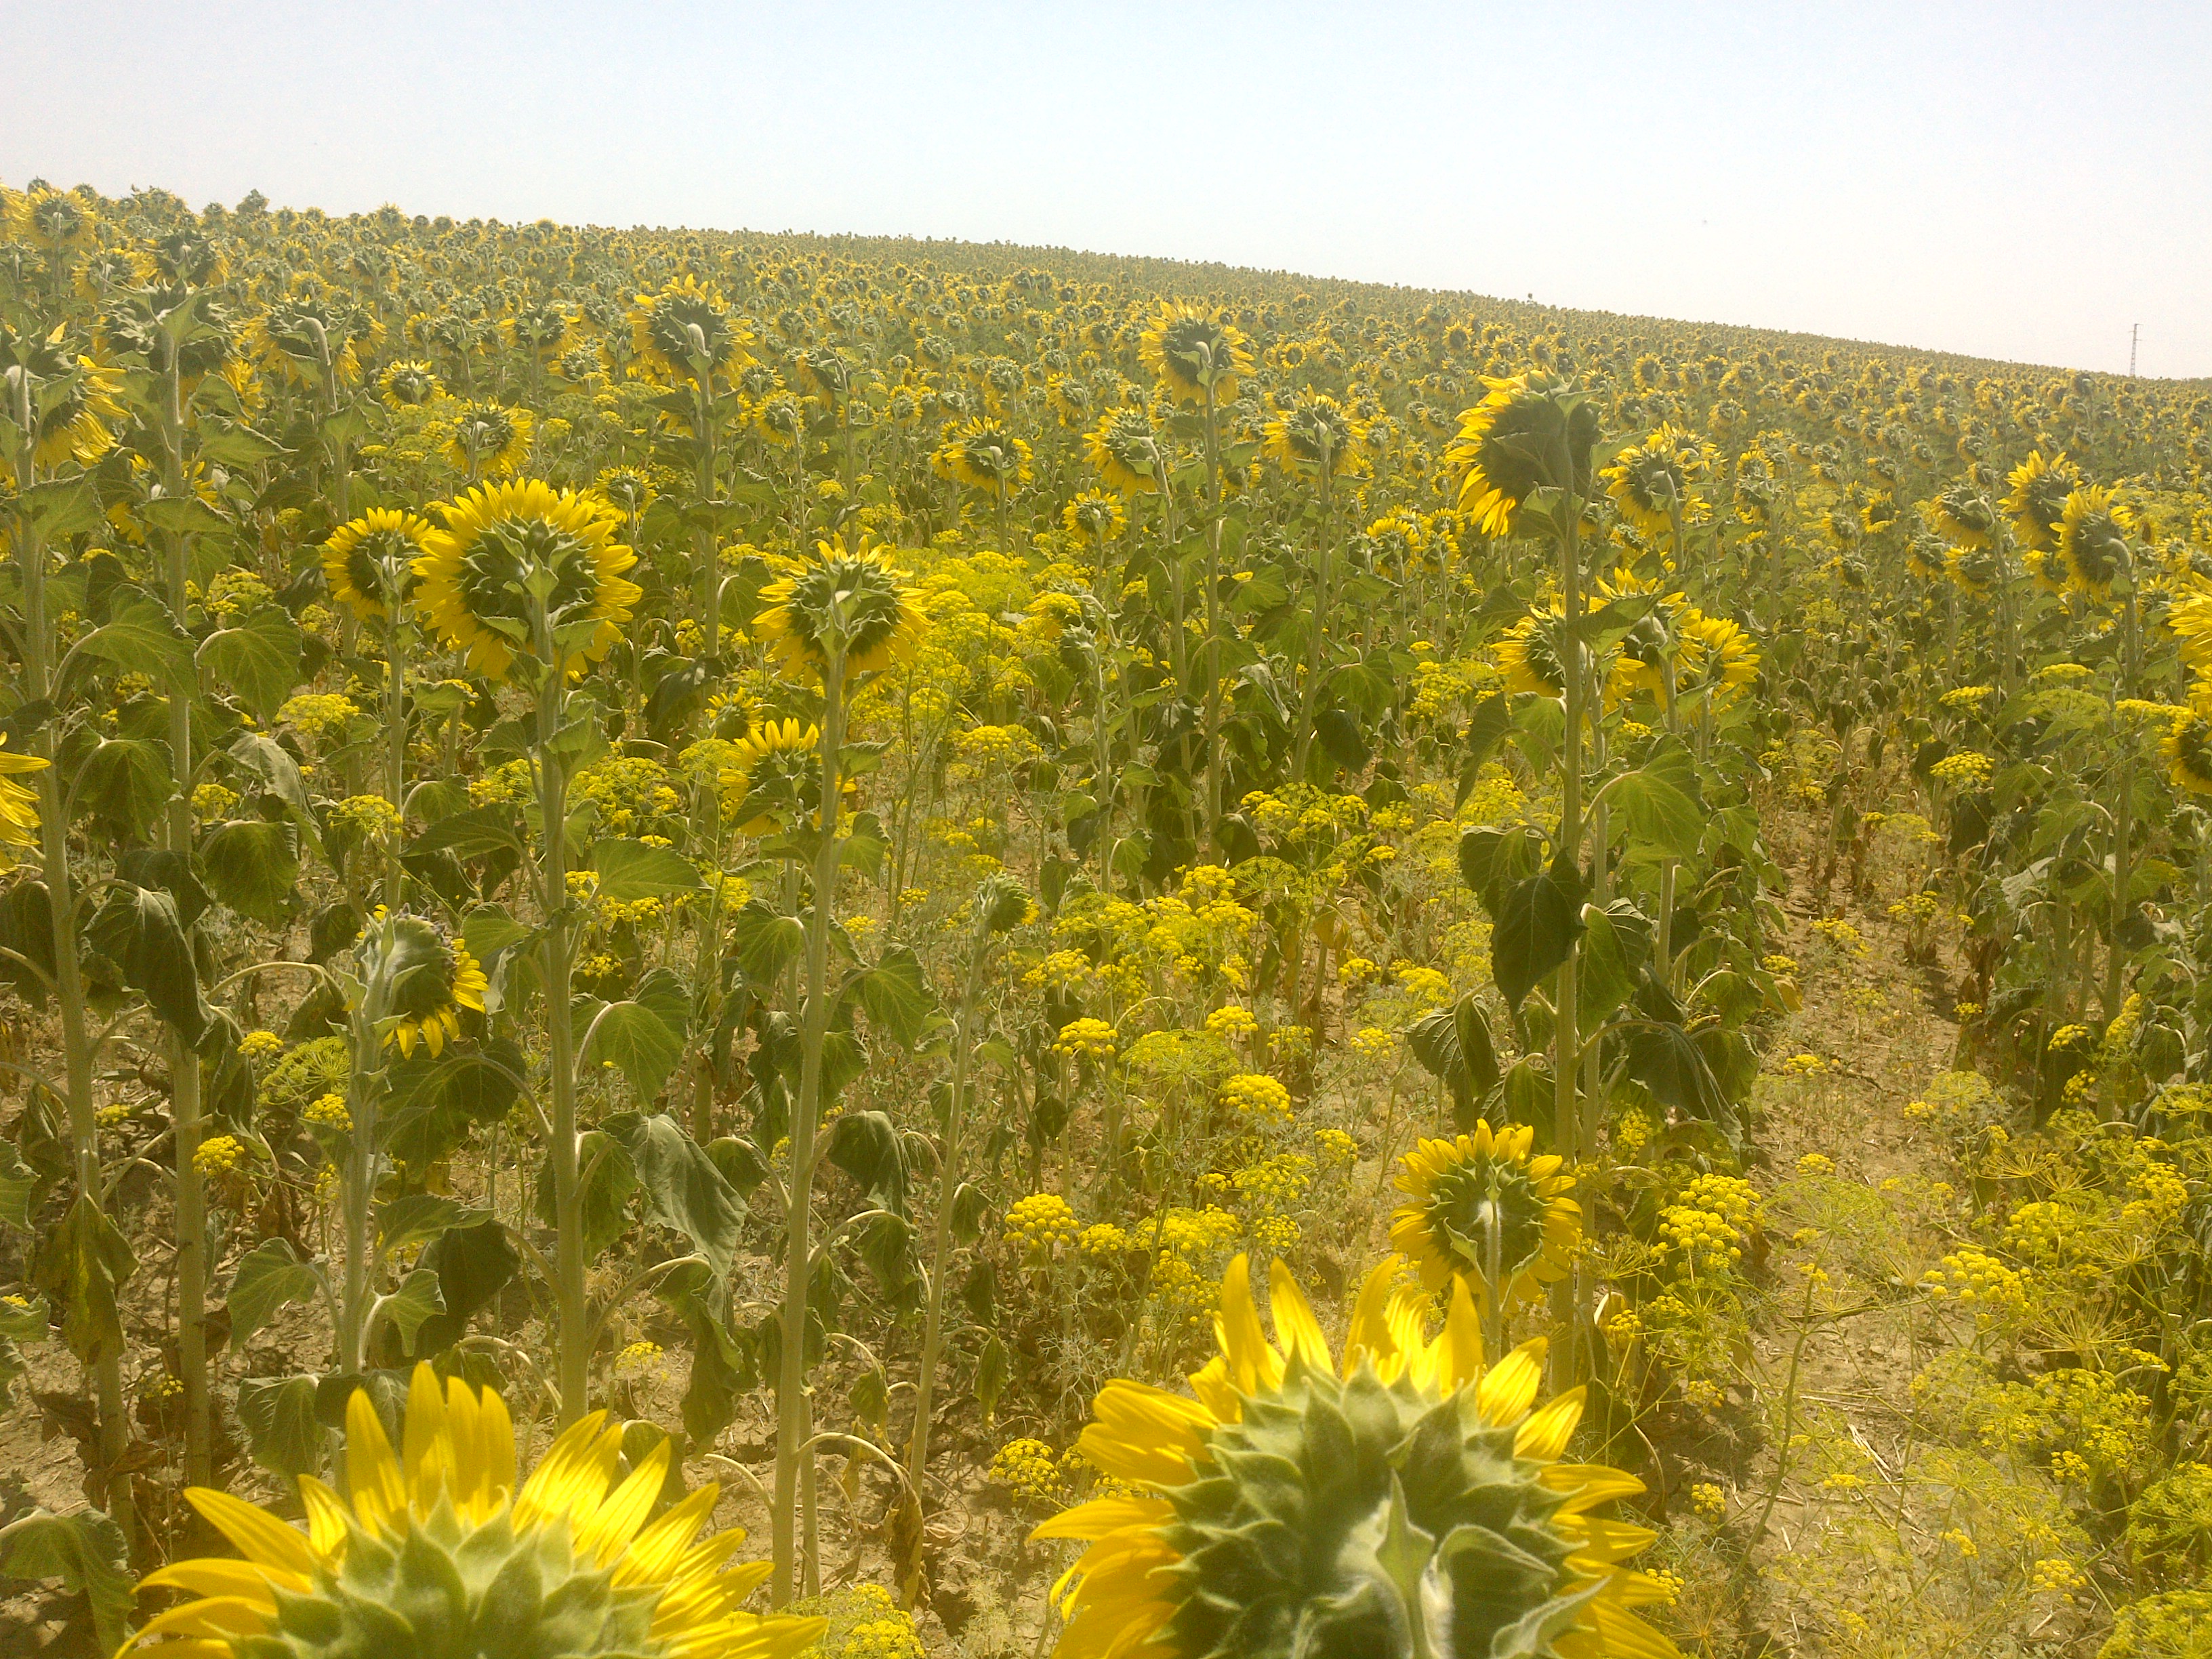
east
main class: Cropland
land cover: Sunflower
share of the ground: > 75 %
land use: Agriculture (excluding fallow land and kitchen gardens)
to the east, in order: Sunflower
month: June
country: ES
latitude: 37.7987
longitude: -4.9036
